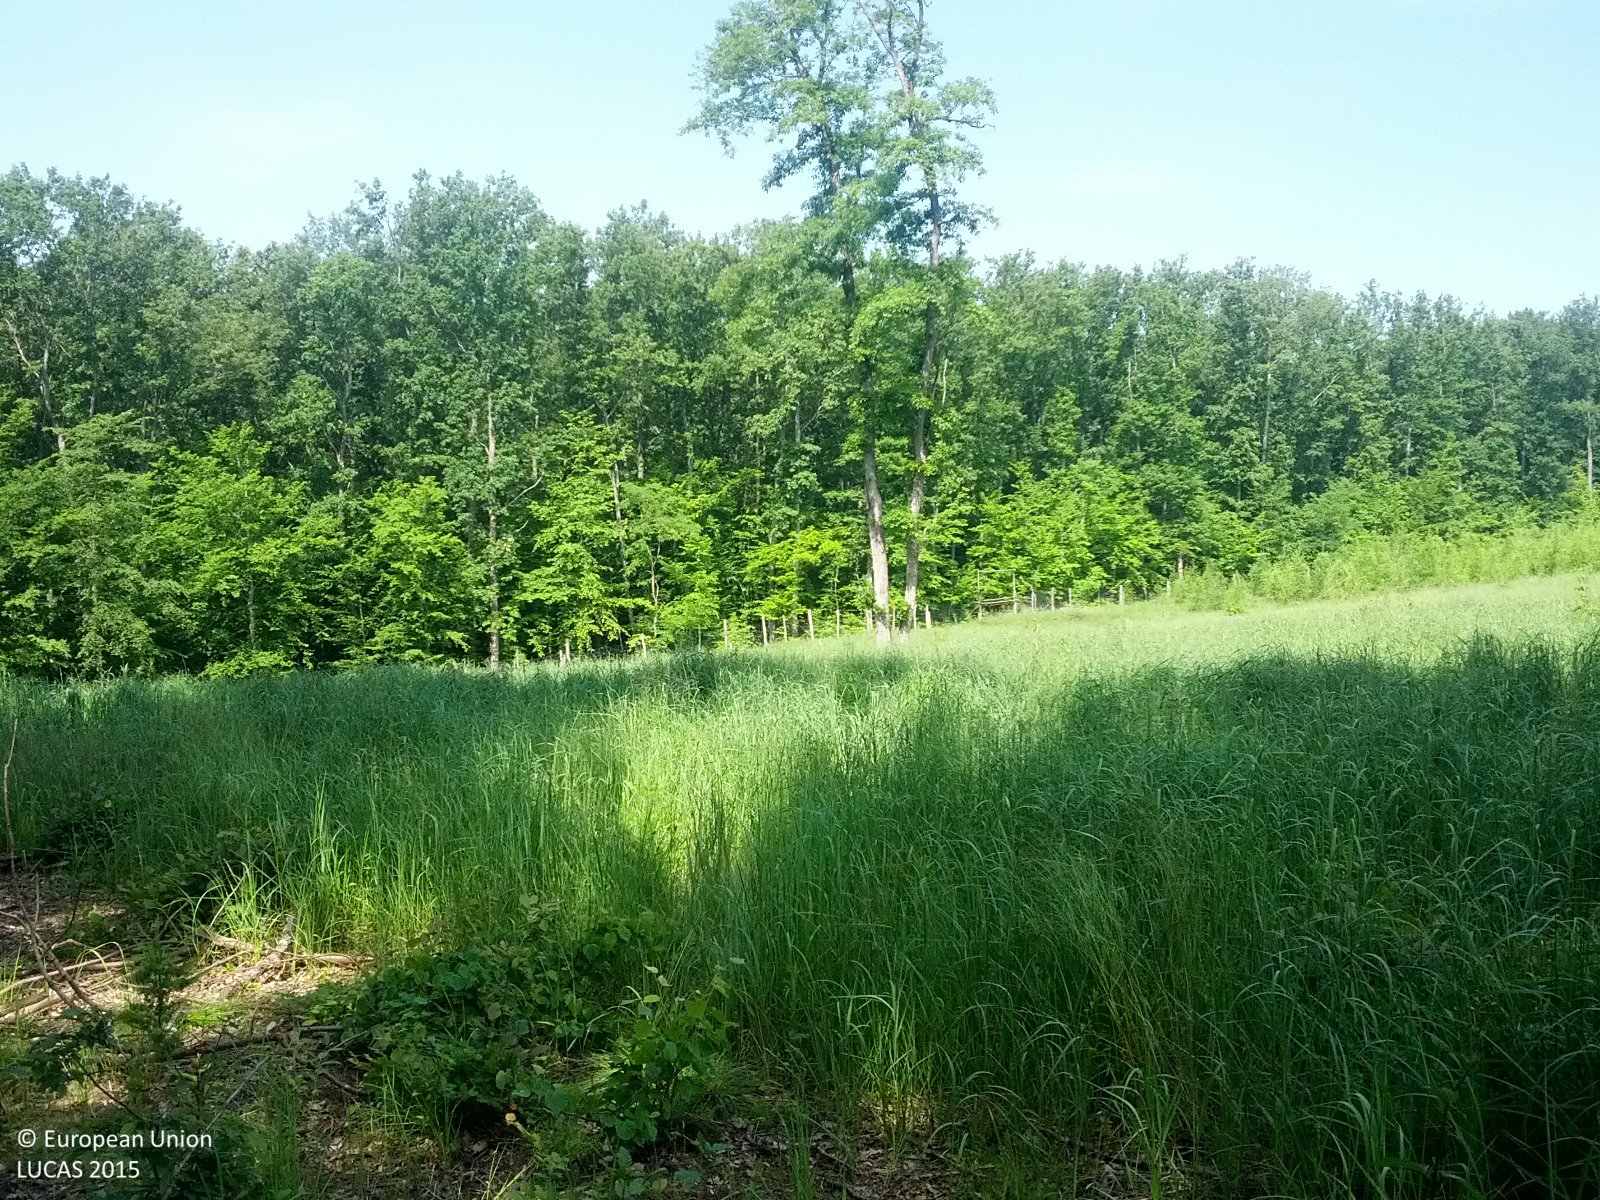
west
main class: Woodland
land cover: Broadleaved woodland
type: beech forest
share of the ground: 50 - 75 %
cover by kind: broadleaved forest trees 60 %, unconsolidated bare surface 20 %, herbaceous plants 15 %, shrubs 5 %
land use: Forestry
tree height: > 5 m
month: June
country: AT
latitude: 47.0992
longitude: 16.3925
